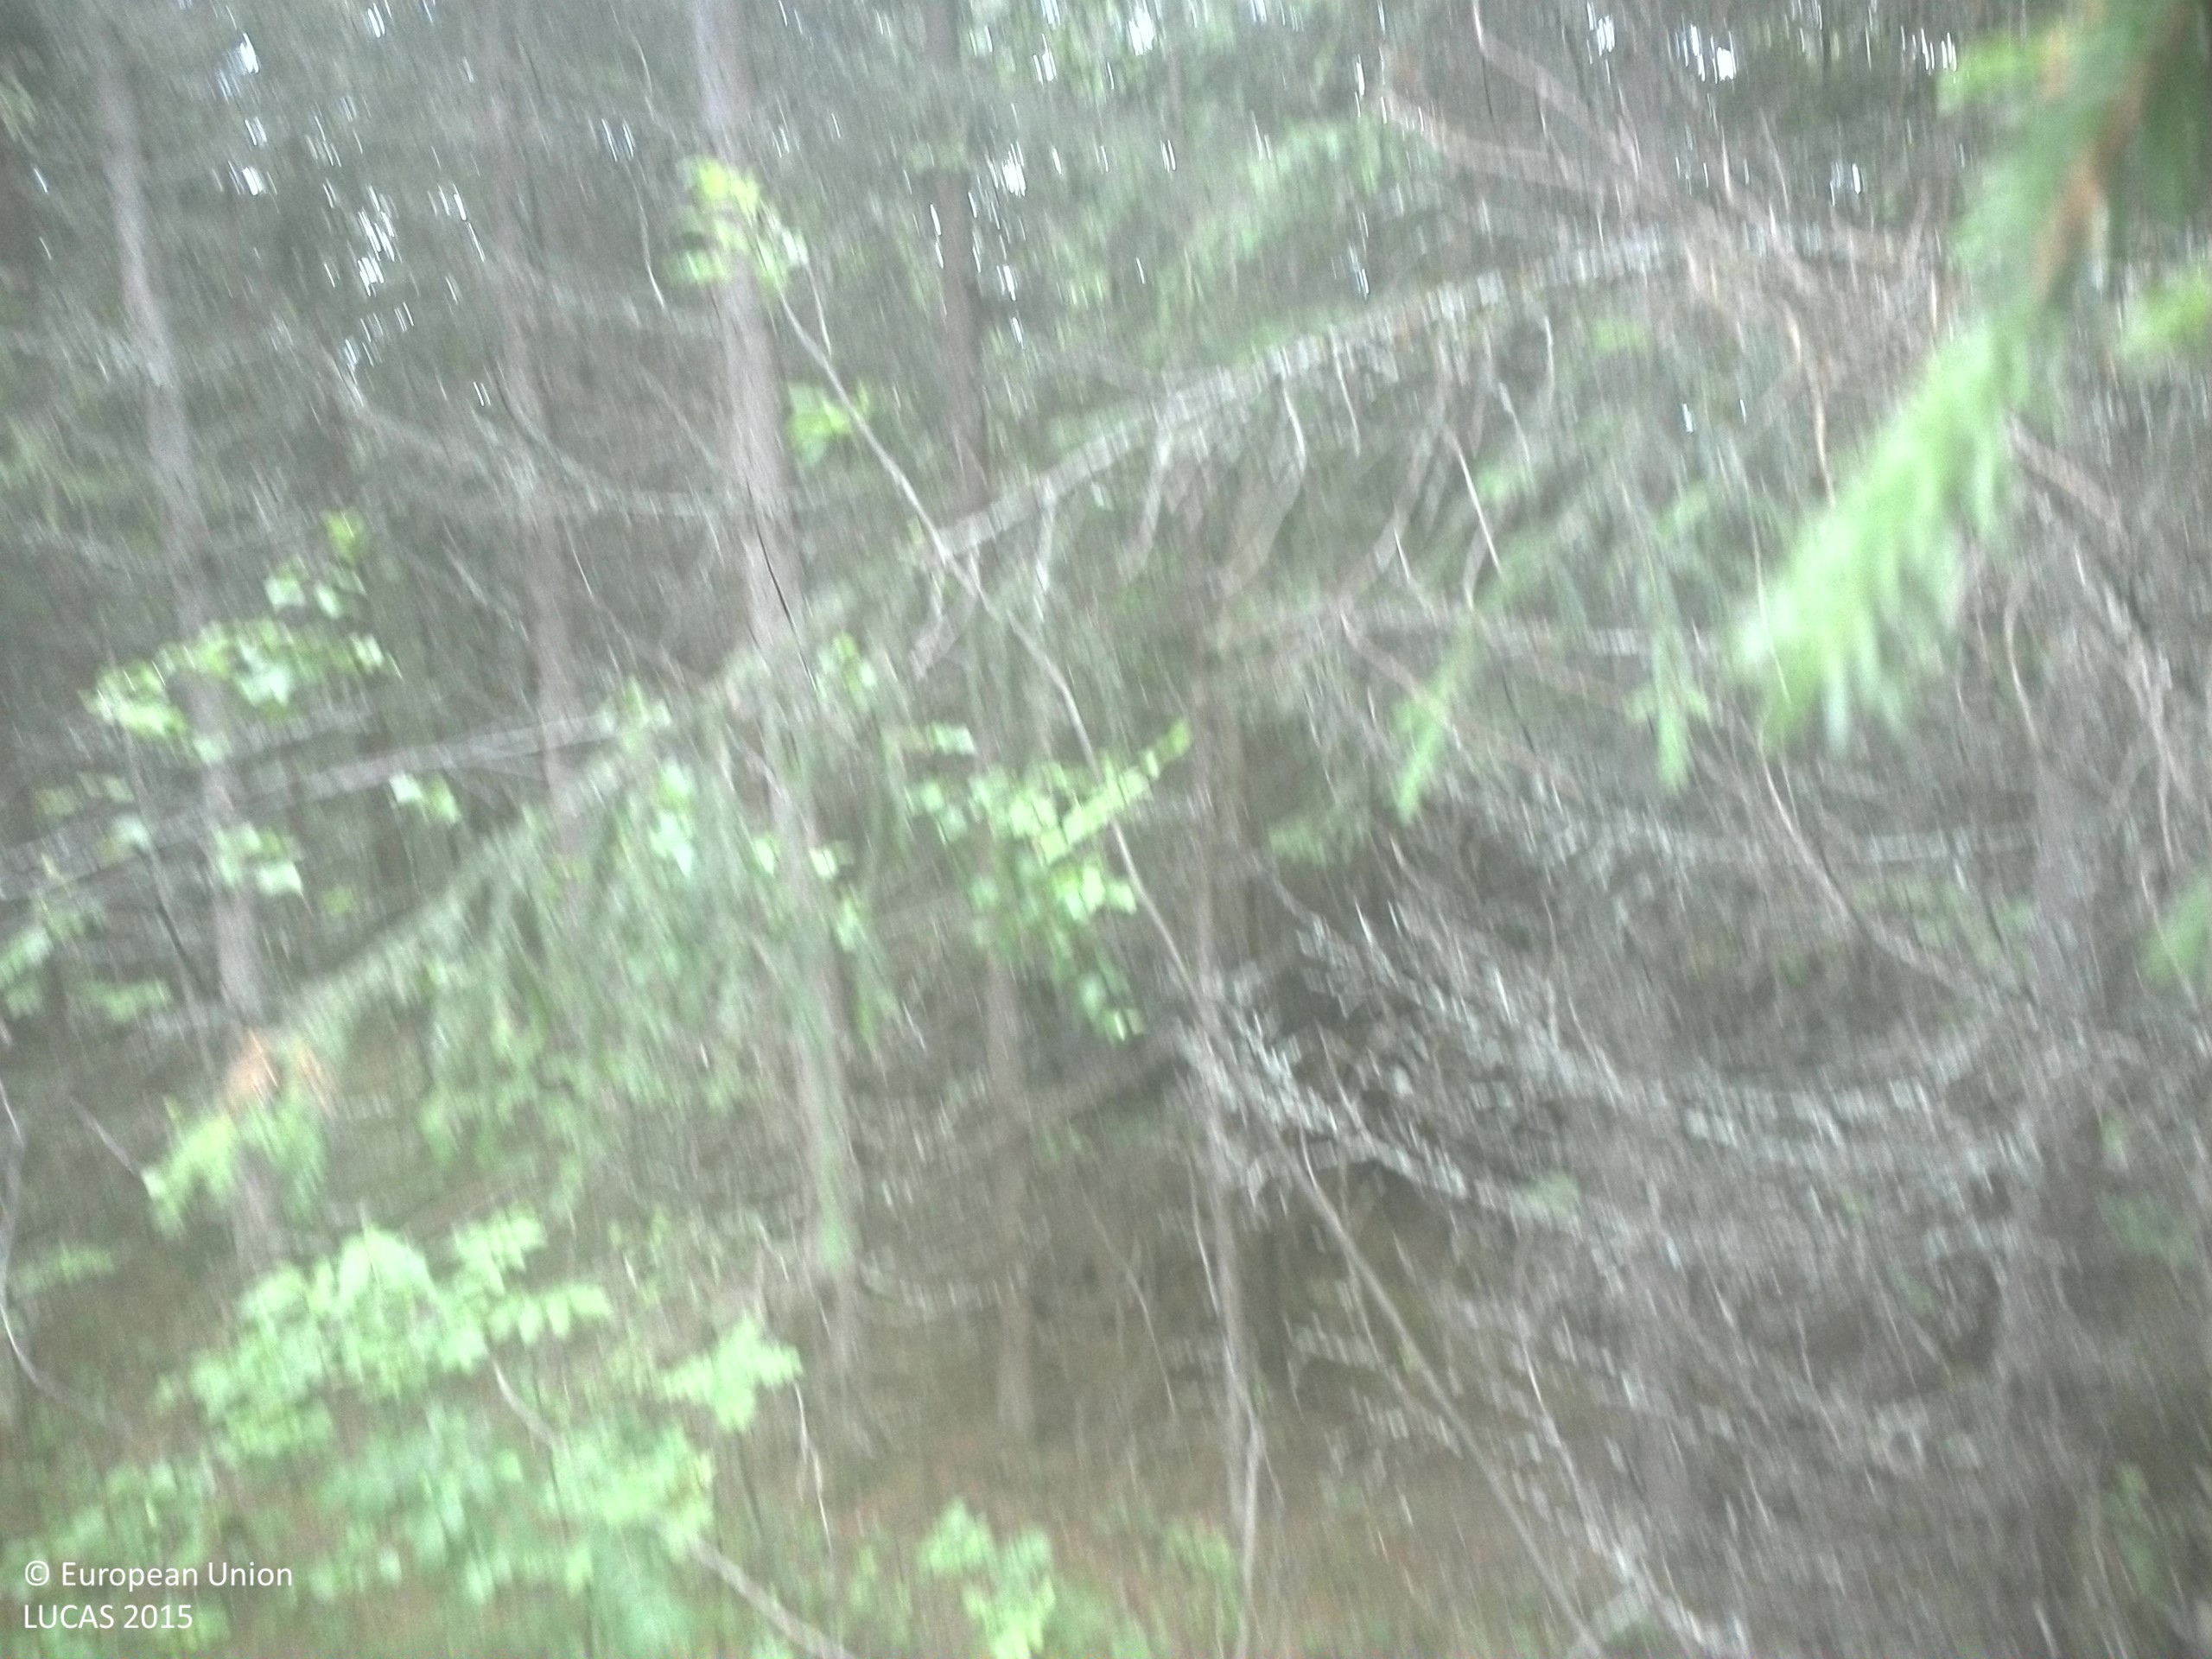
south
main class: Woodland
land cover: Spruce dominated coniferous woodland
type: boreal forest
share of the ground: > 75 %
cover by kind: coniferous forest trees 75 %, shrubs 15 %, broadleaved forest trees 10 %
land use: Forestry
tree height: > 5 m
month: July
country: SE
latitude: 63.5842
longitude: 18.5785
